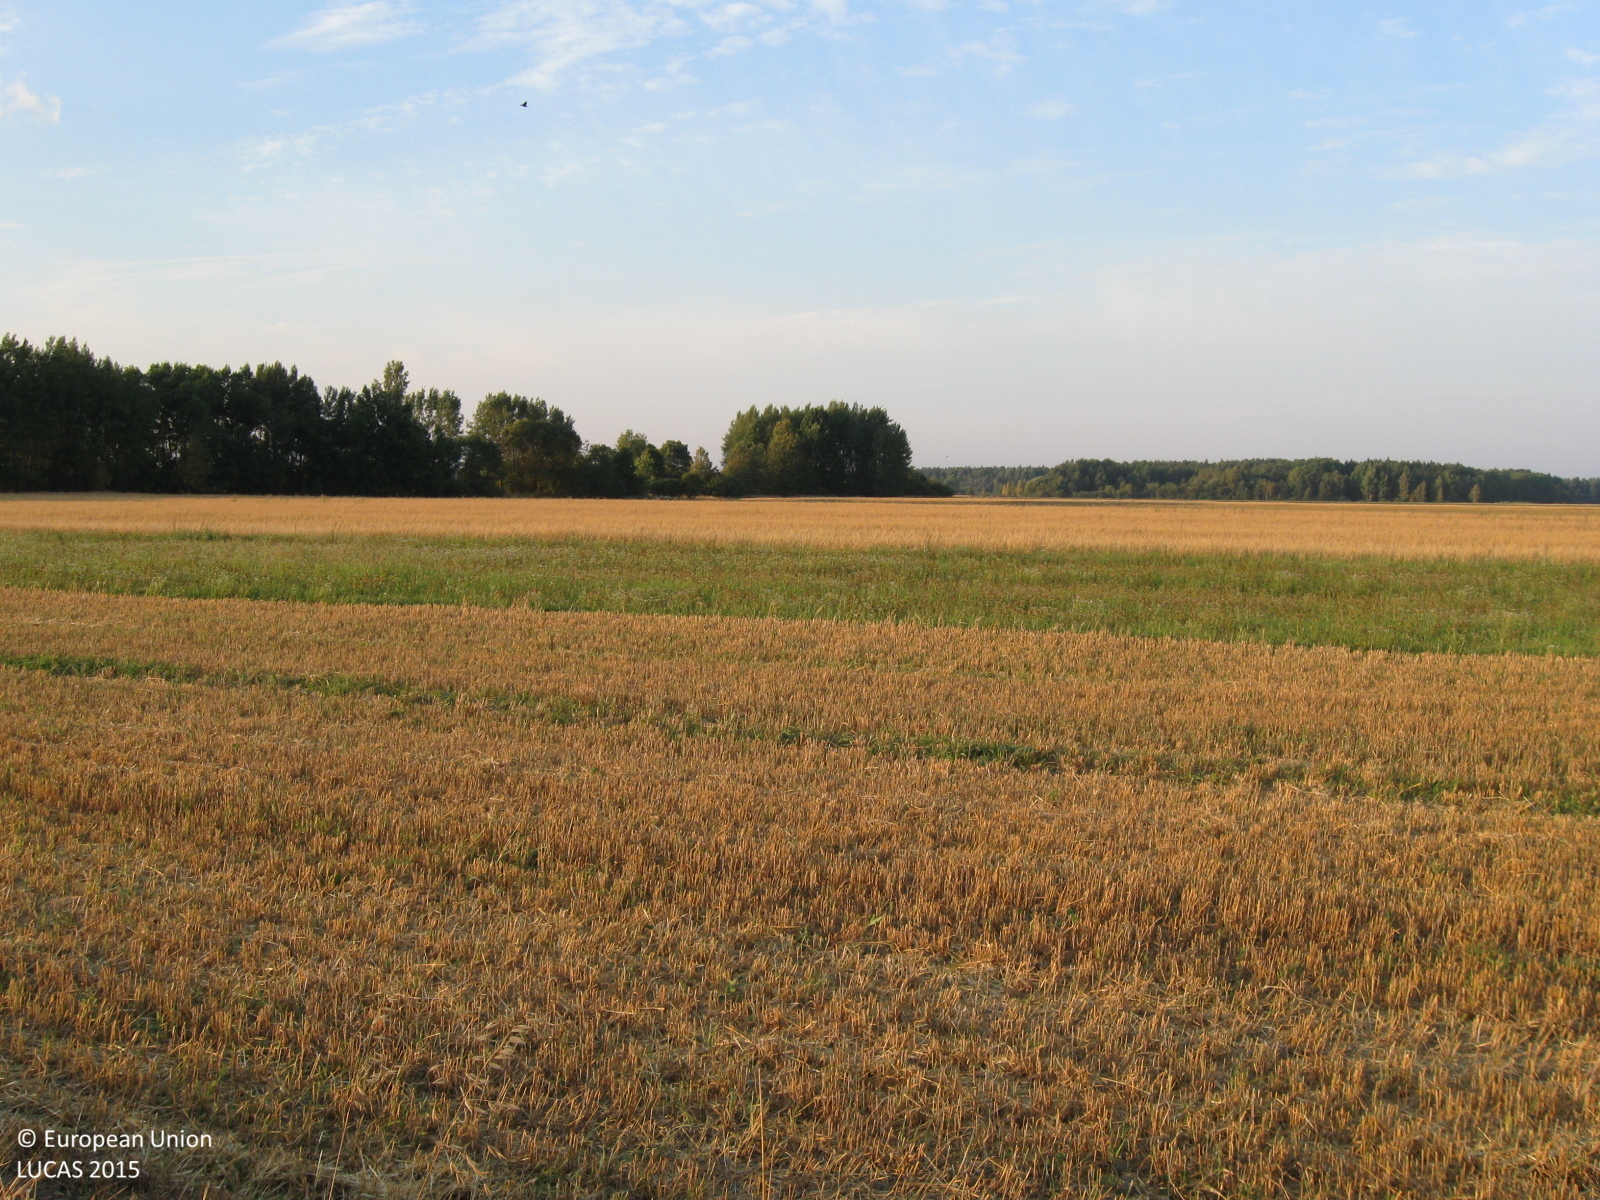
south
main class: Cropland
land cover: Barley
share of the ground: > 75 %
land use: Agriculture (excluding fallow land and kitchen gardens)
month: August
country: LT
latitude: 55.3694
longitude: 22.8961
